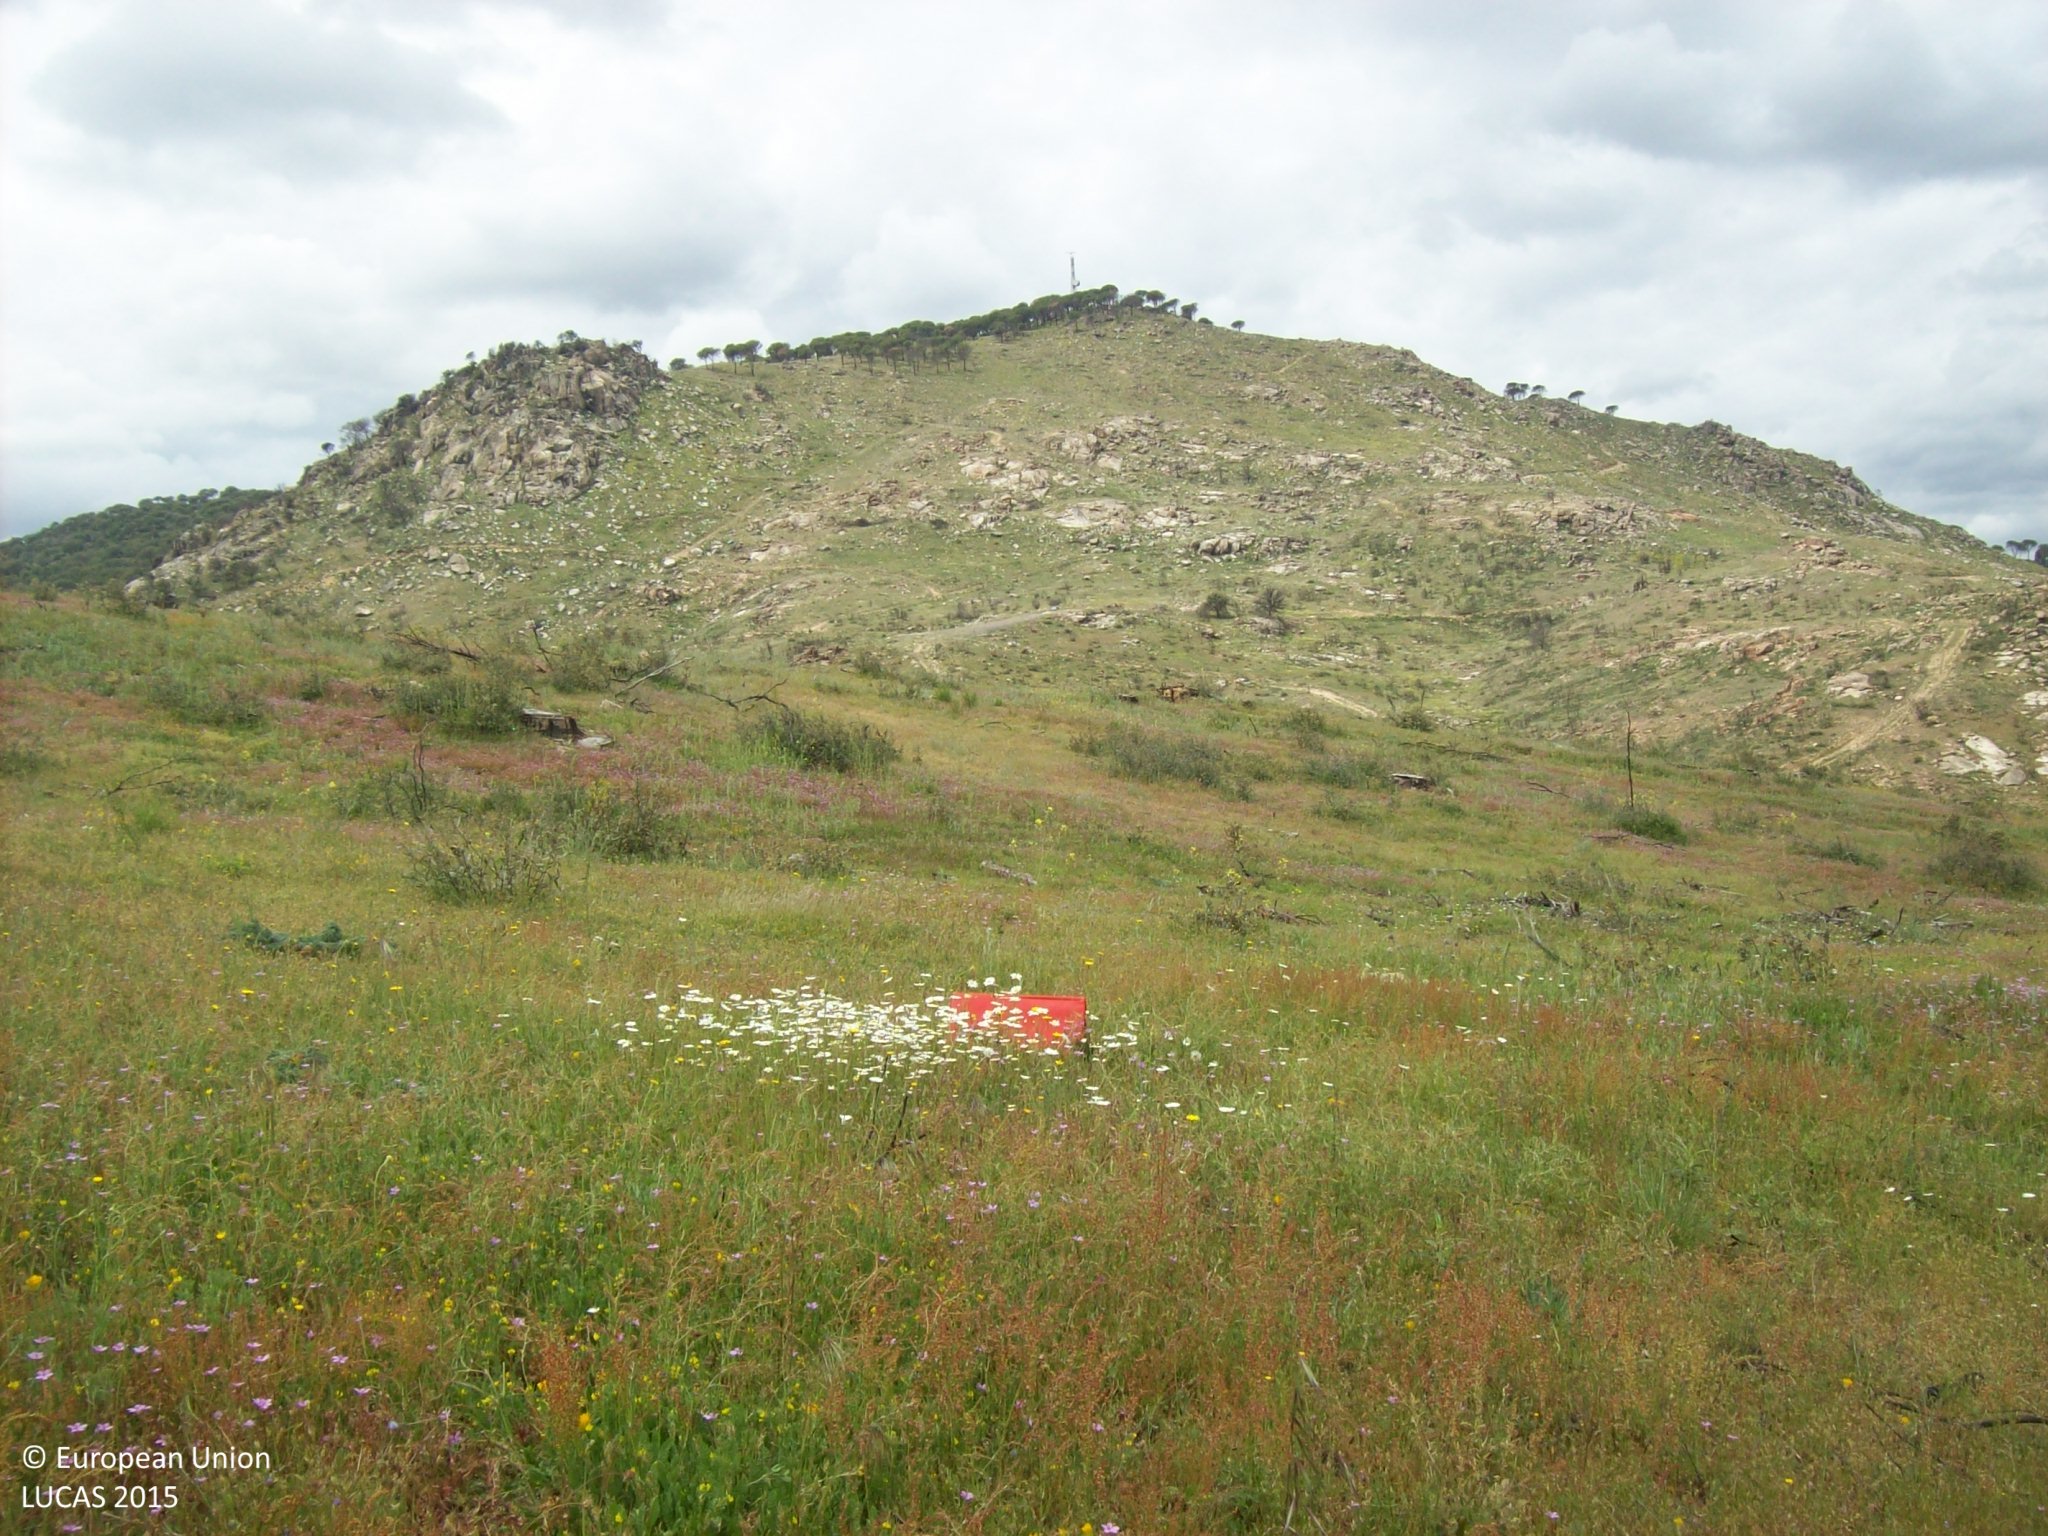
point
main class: Grassland
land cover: Grassland without tree/shrub cover
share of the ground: > 75 %
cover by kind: herbaceous plants 100 %
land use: Semi-natural and natural areas not in use
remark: Burnt area
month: April
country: ES
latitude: 40.4500
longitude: -4.3736
